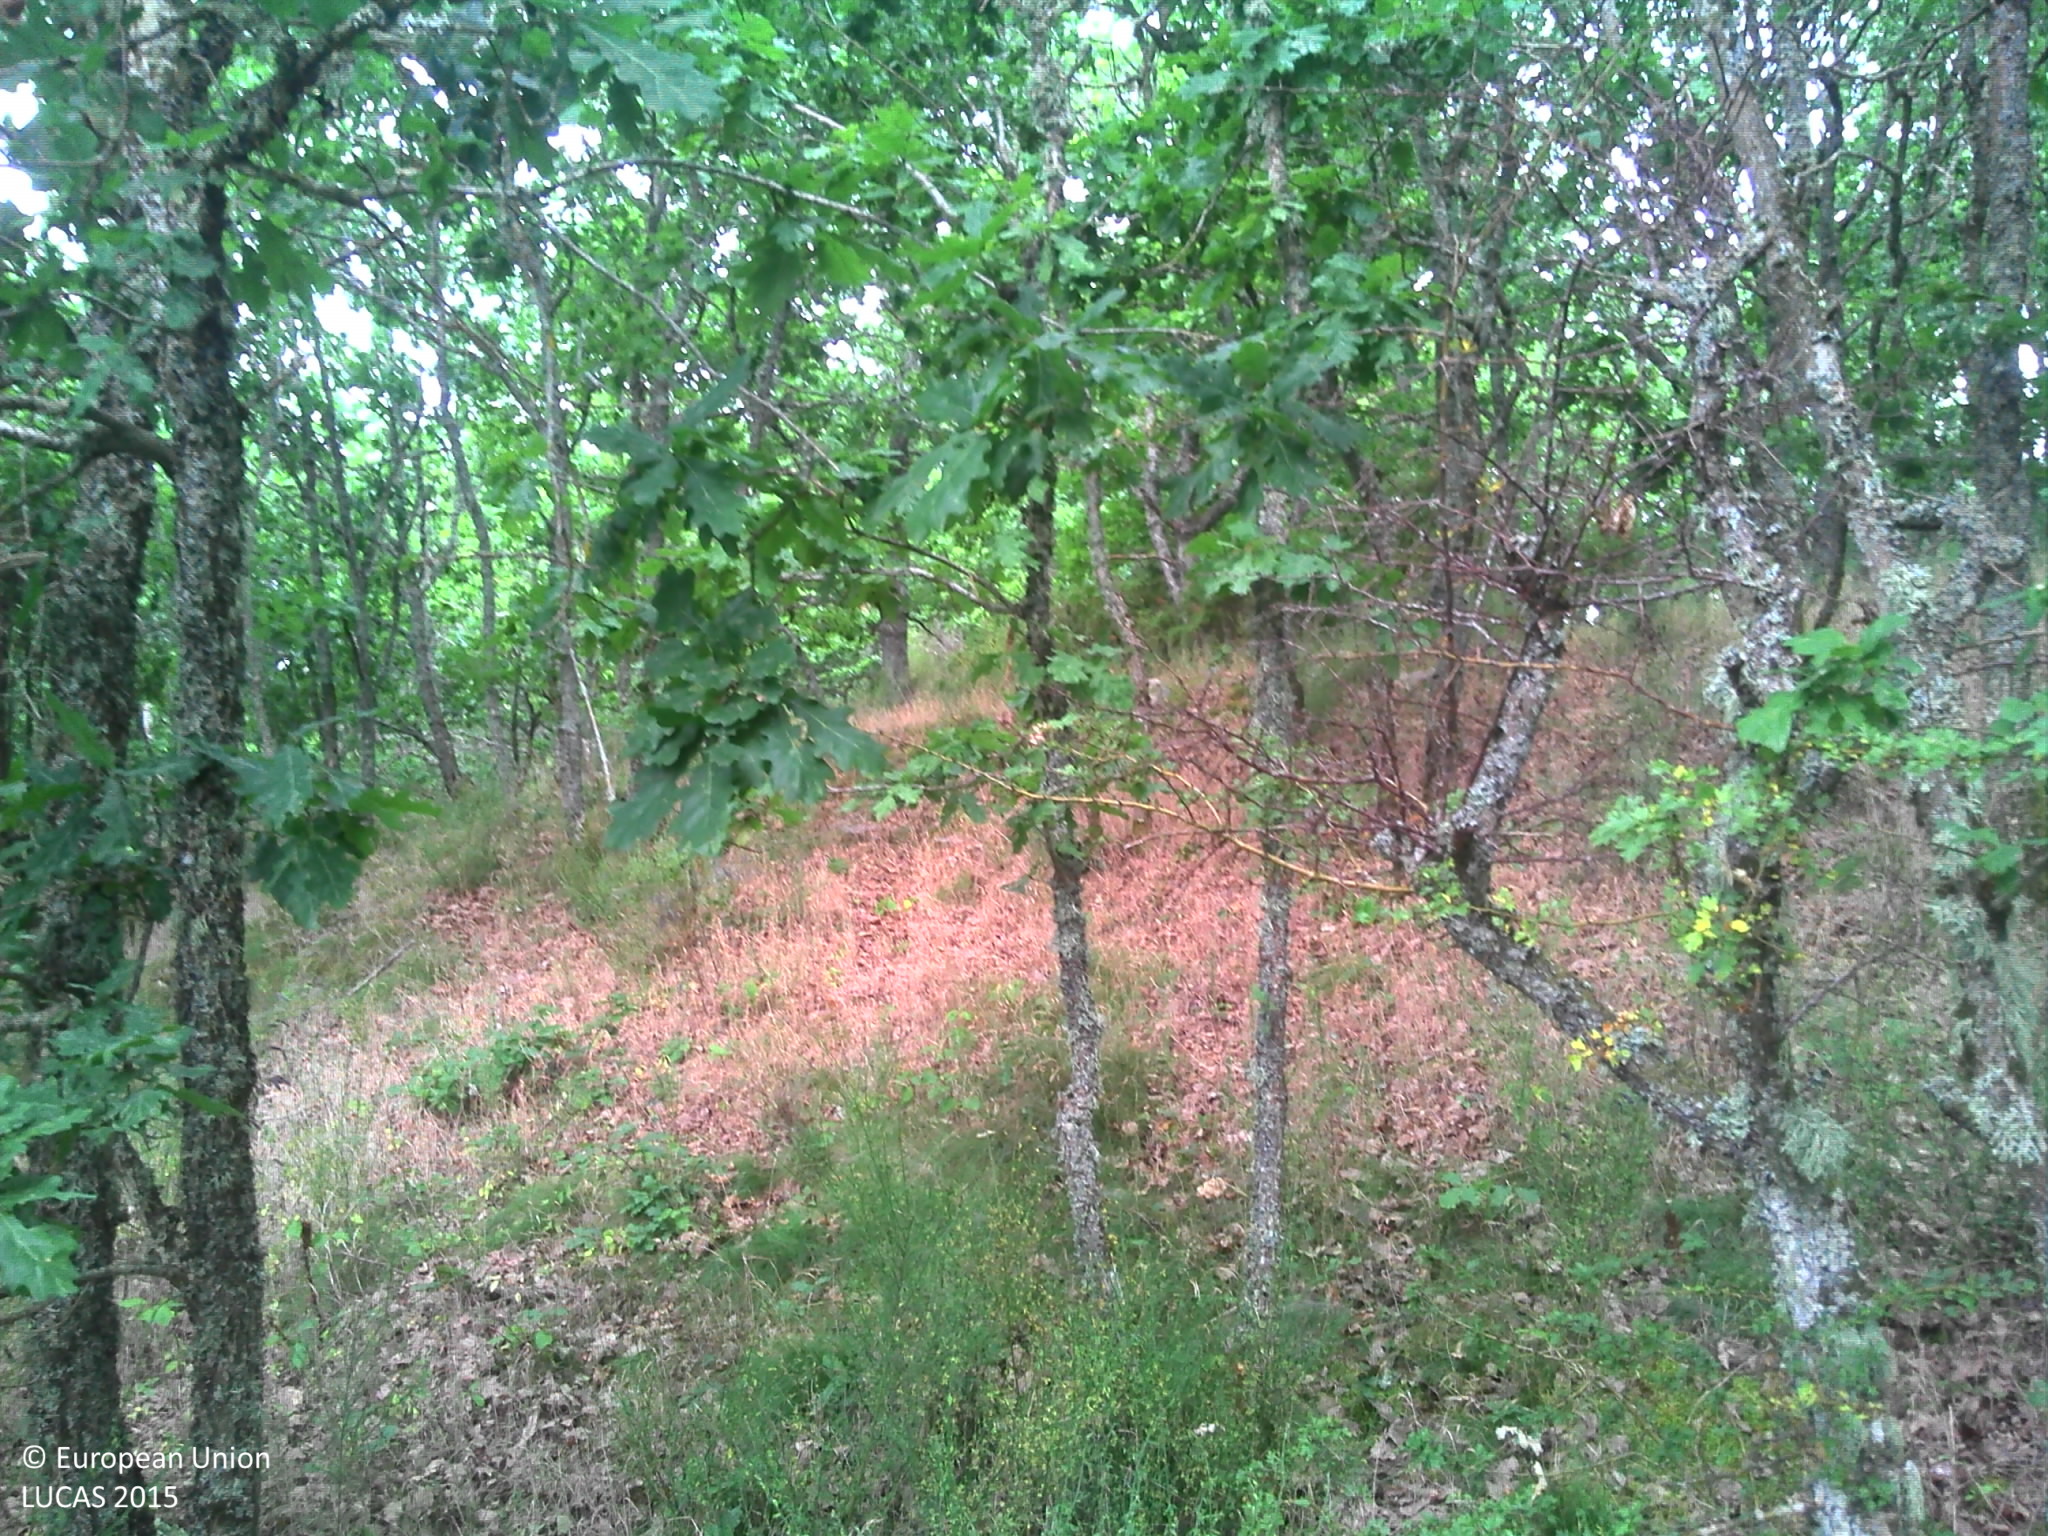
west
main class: Woodland
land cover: Broadleaved woodland
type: acidophilous oak and oak-birch forest
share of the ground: > 75 %
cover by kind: herbaceous plants 40 %, broadleaved forest trees 30 %, shrubs 25 %, lichens and mosses 5 %
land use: Forestry
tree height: > 5 m
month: July
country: FR
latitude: 45.9244
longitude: 3.0229
